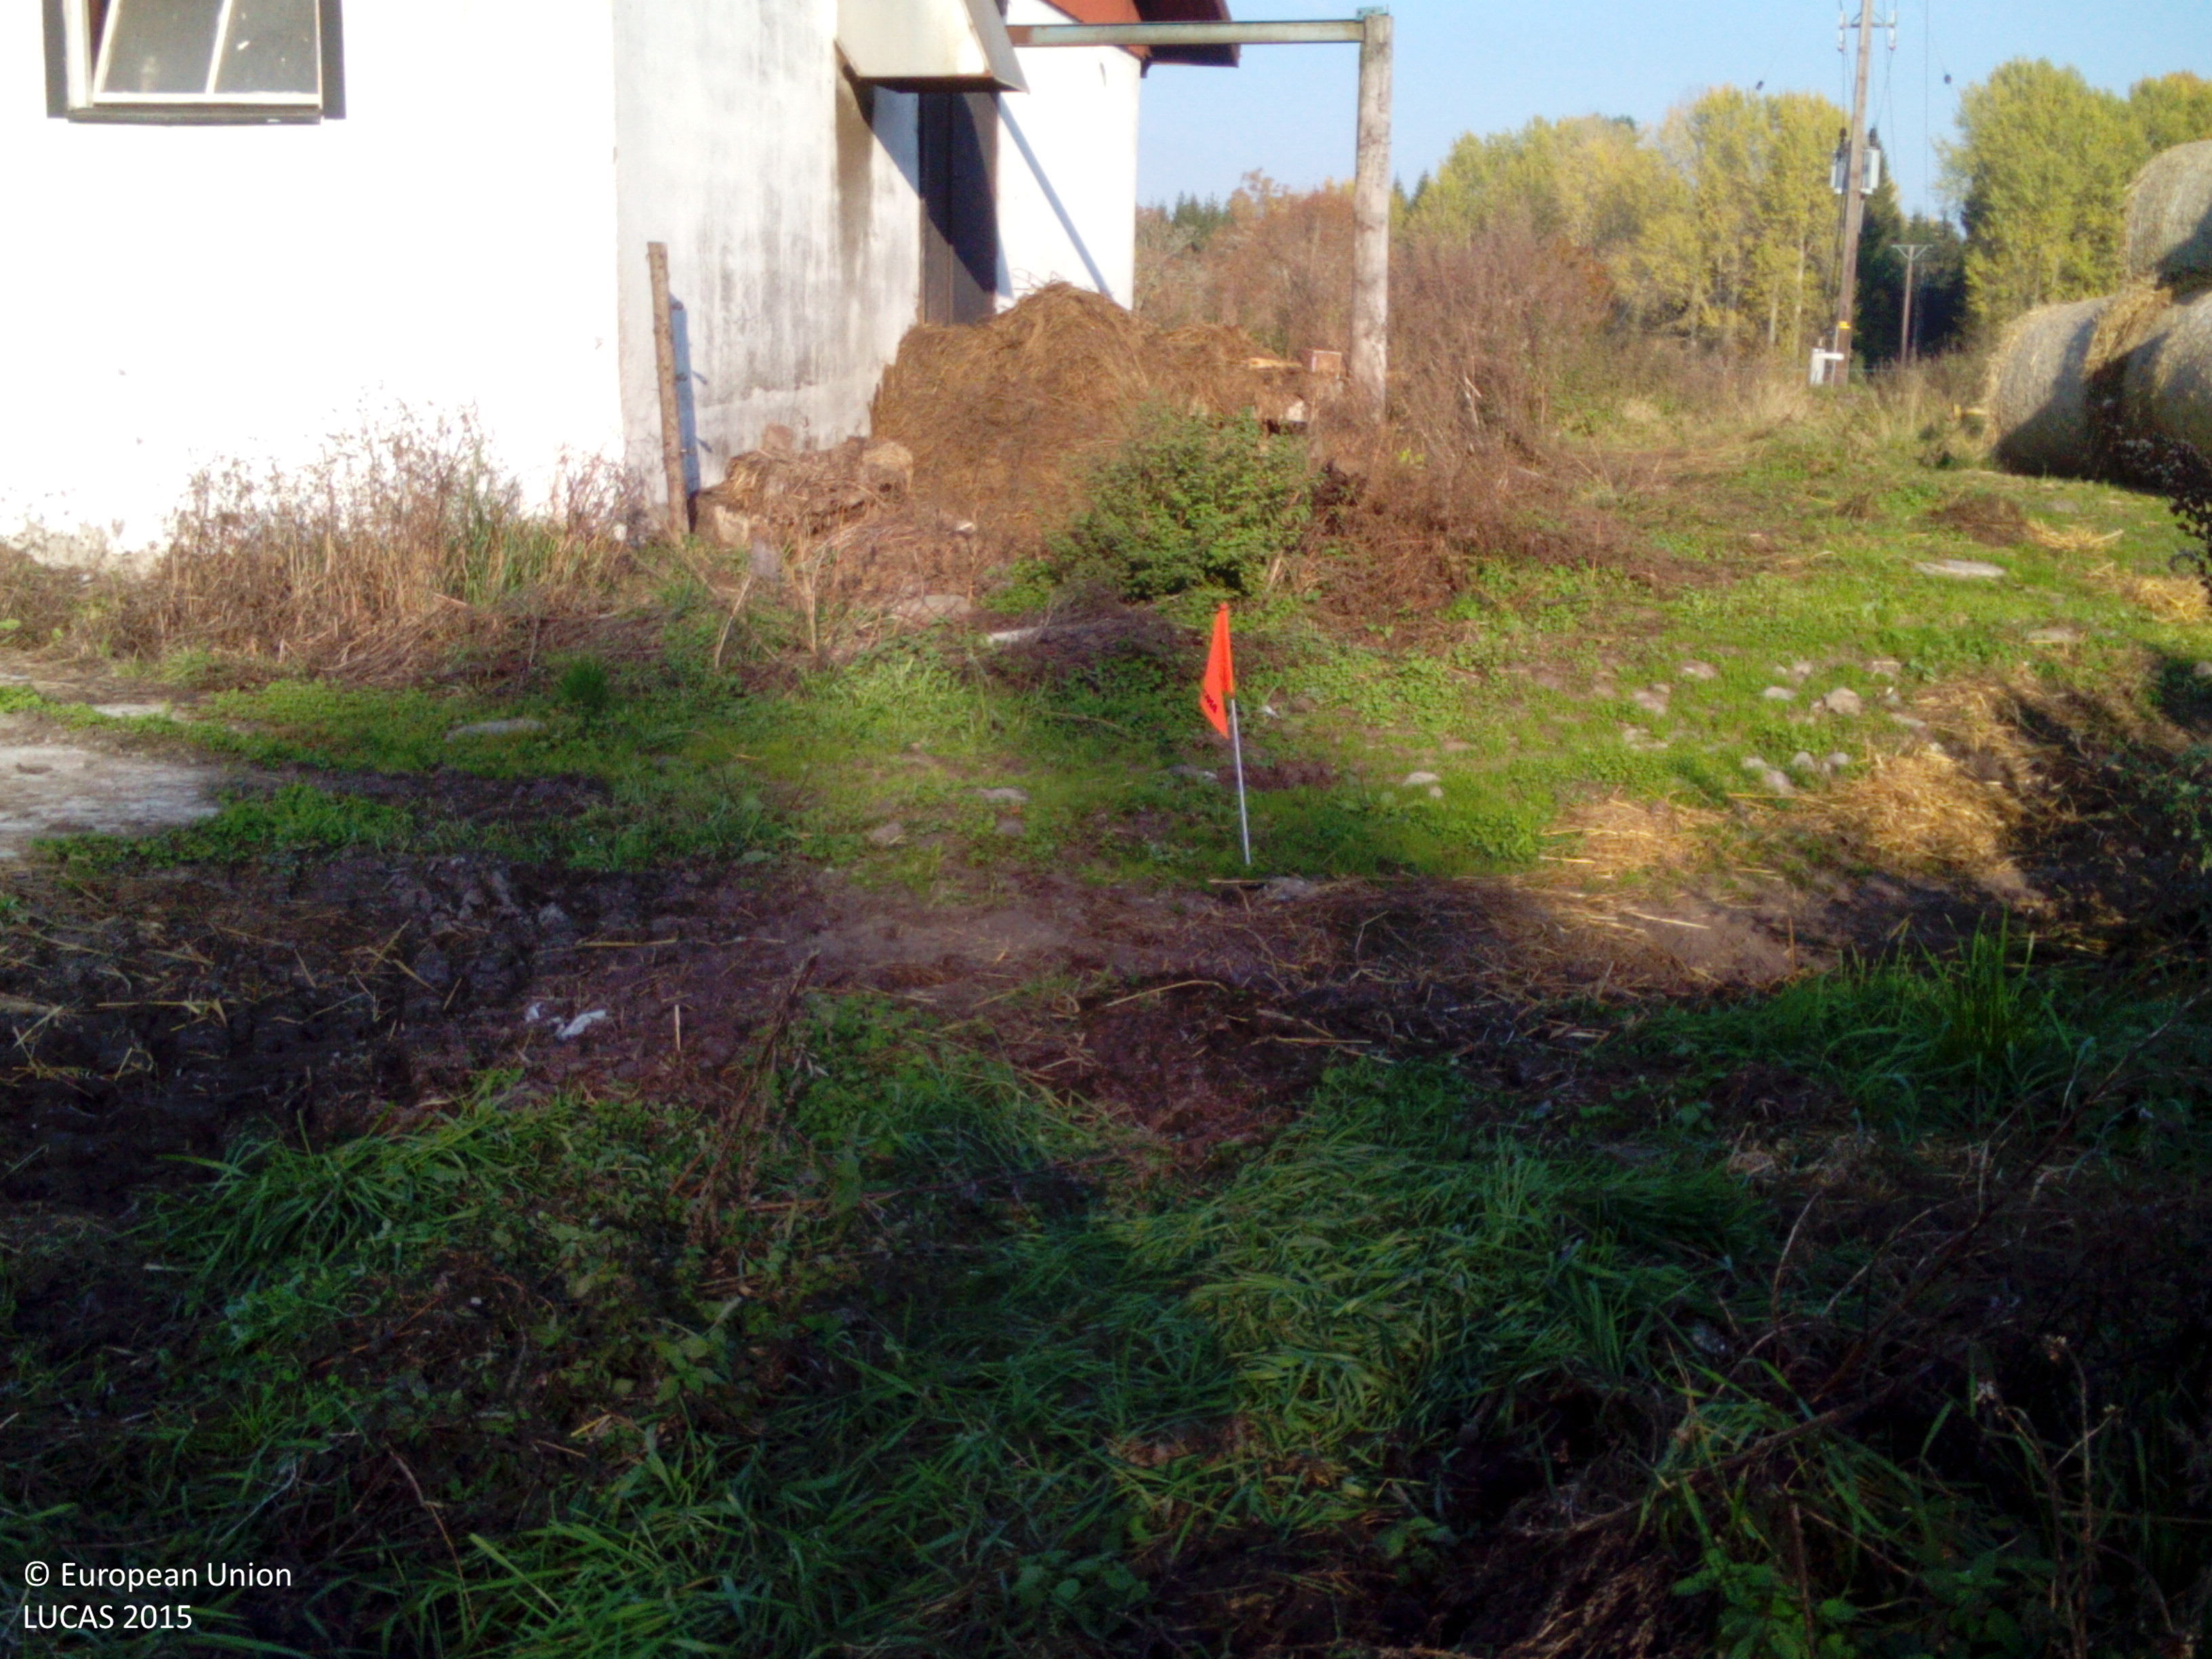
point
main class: Grassland
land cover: Spontaneously vegetated surfaces
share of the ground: 50 - 75 %
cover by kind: herbaceous plants 65 %, consolidated bare surface 10 %, unconsolidated bare surface 10 %
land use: Agriculture (excluding fallow land and kitchen gardens)
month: October
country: SE
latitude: 58.8682
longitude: 16.2544
